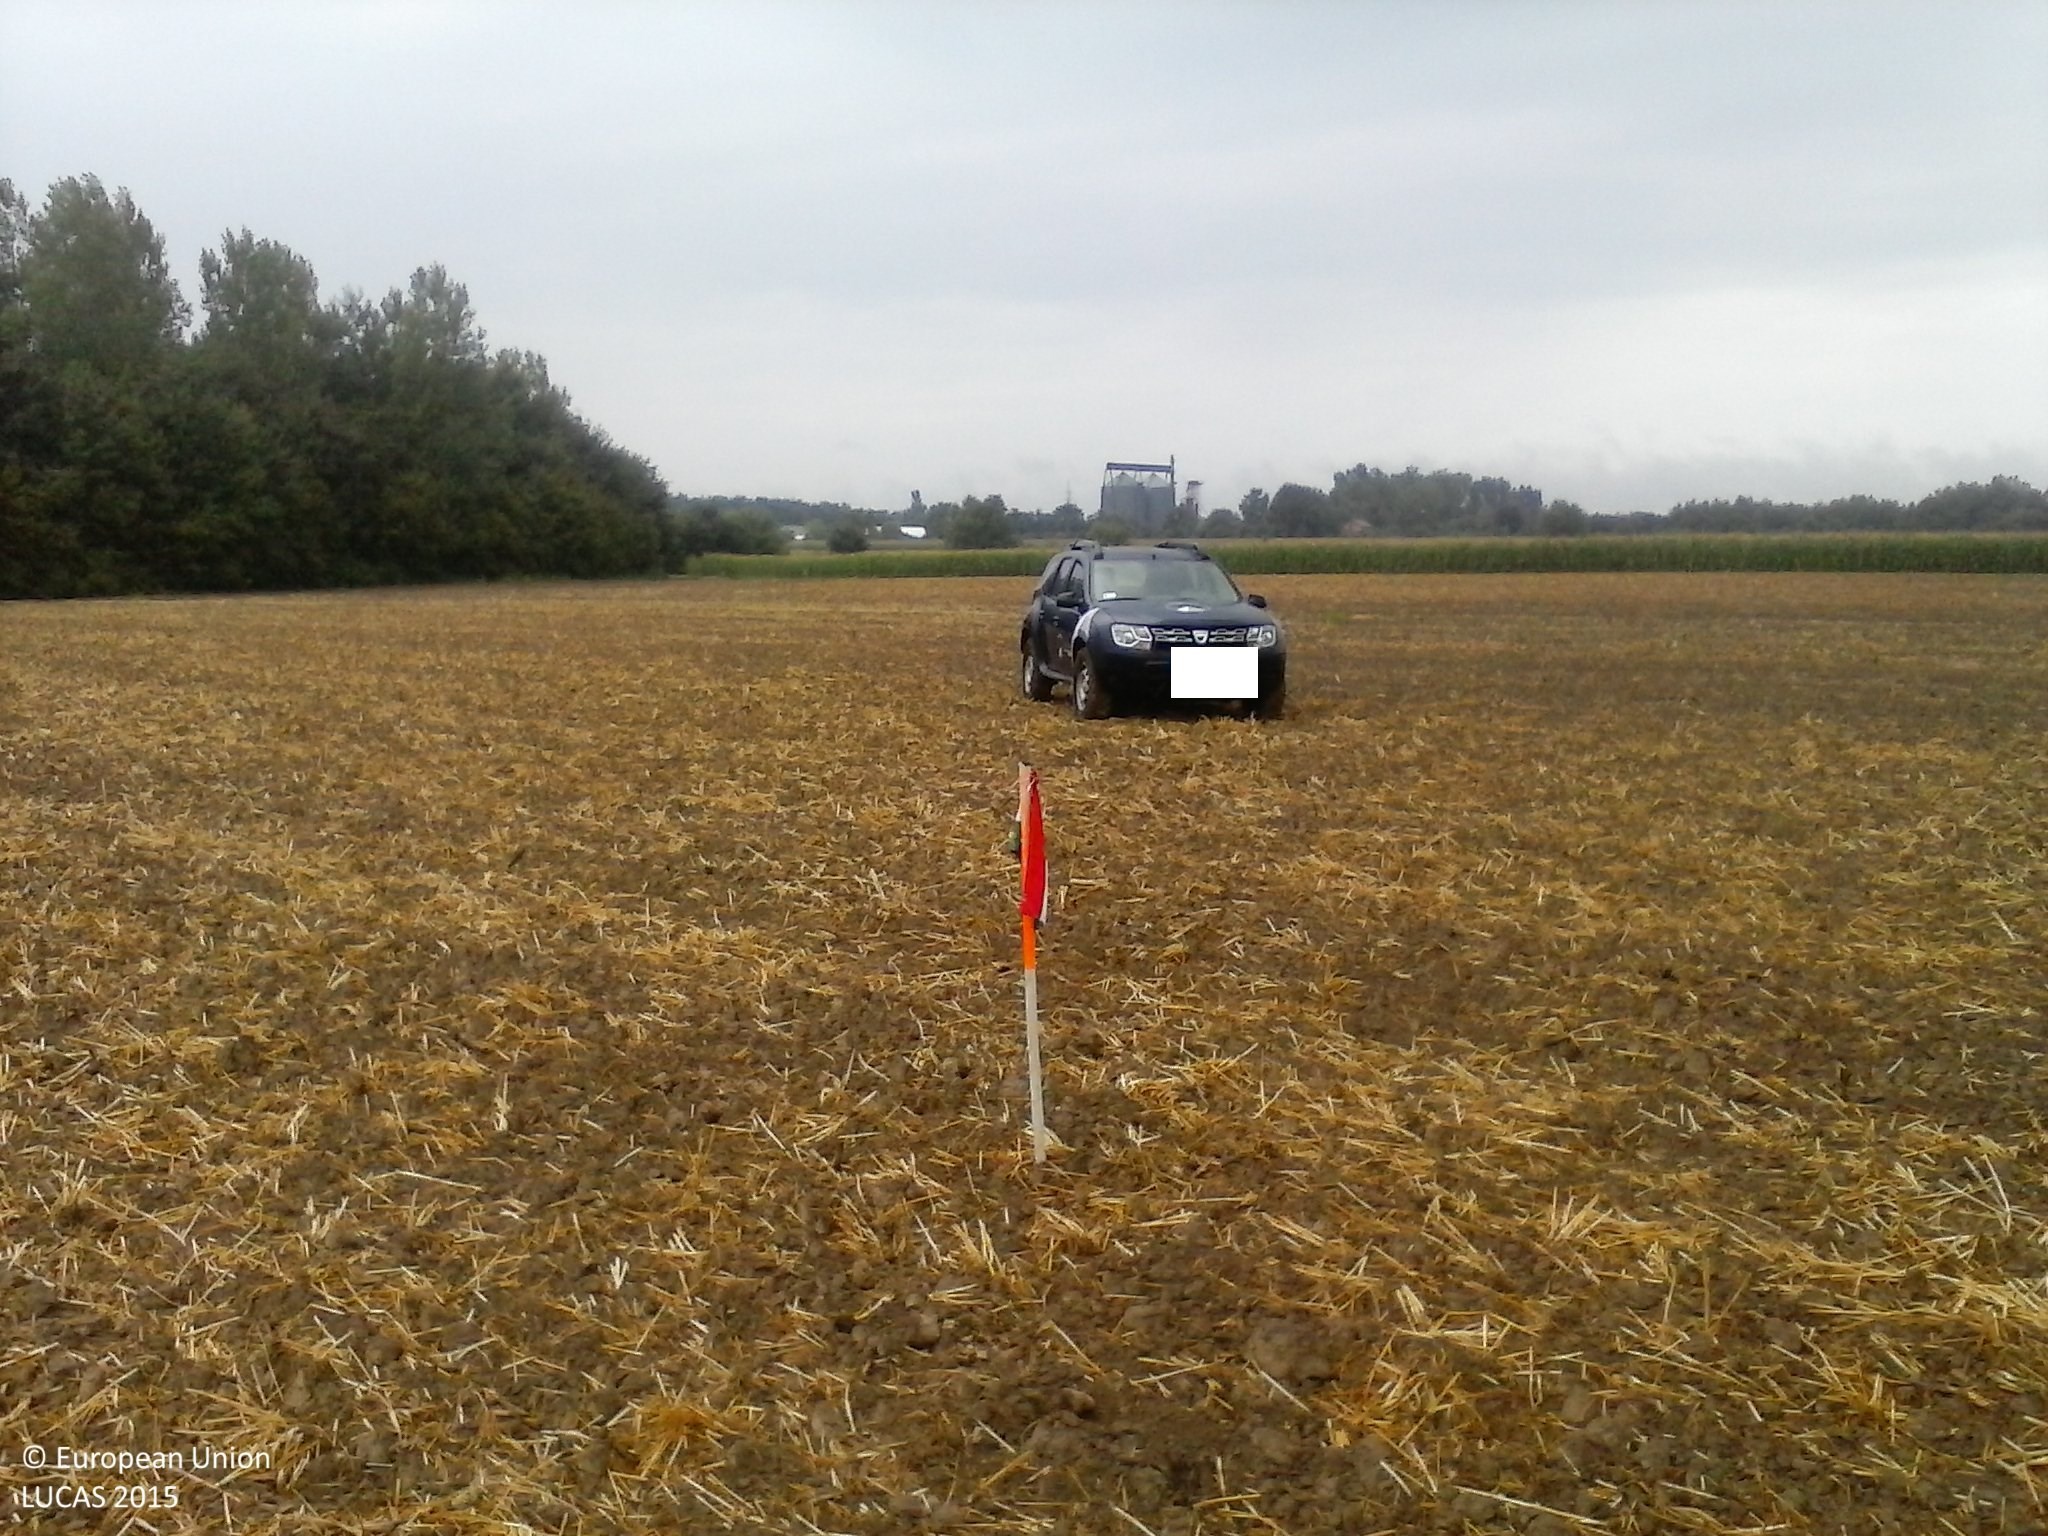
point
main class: Cropland
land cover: Common wheat
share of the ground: 25 - 50 %
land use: Agriculture (excluding fallow land and kitchen gardens)
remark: Harvested field
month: July
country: HU
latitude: 45.9896
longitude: 17.6077
